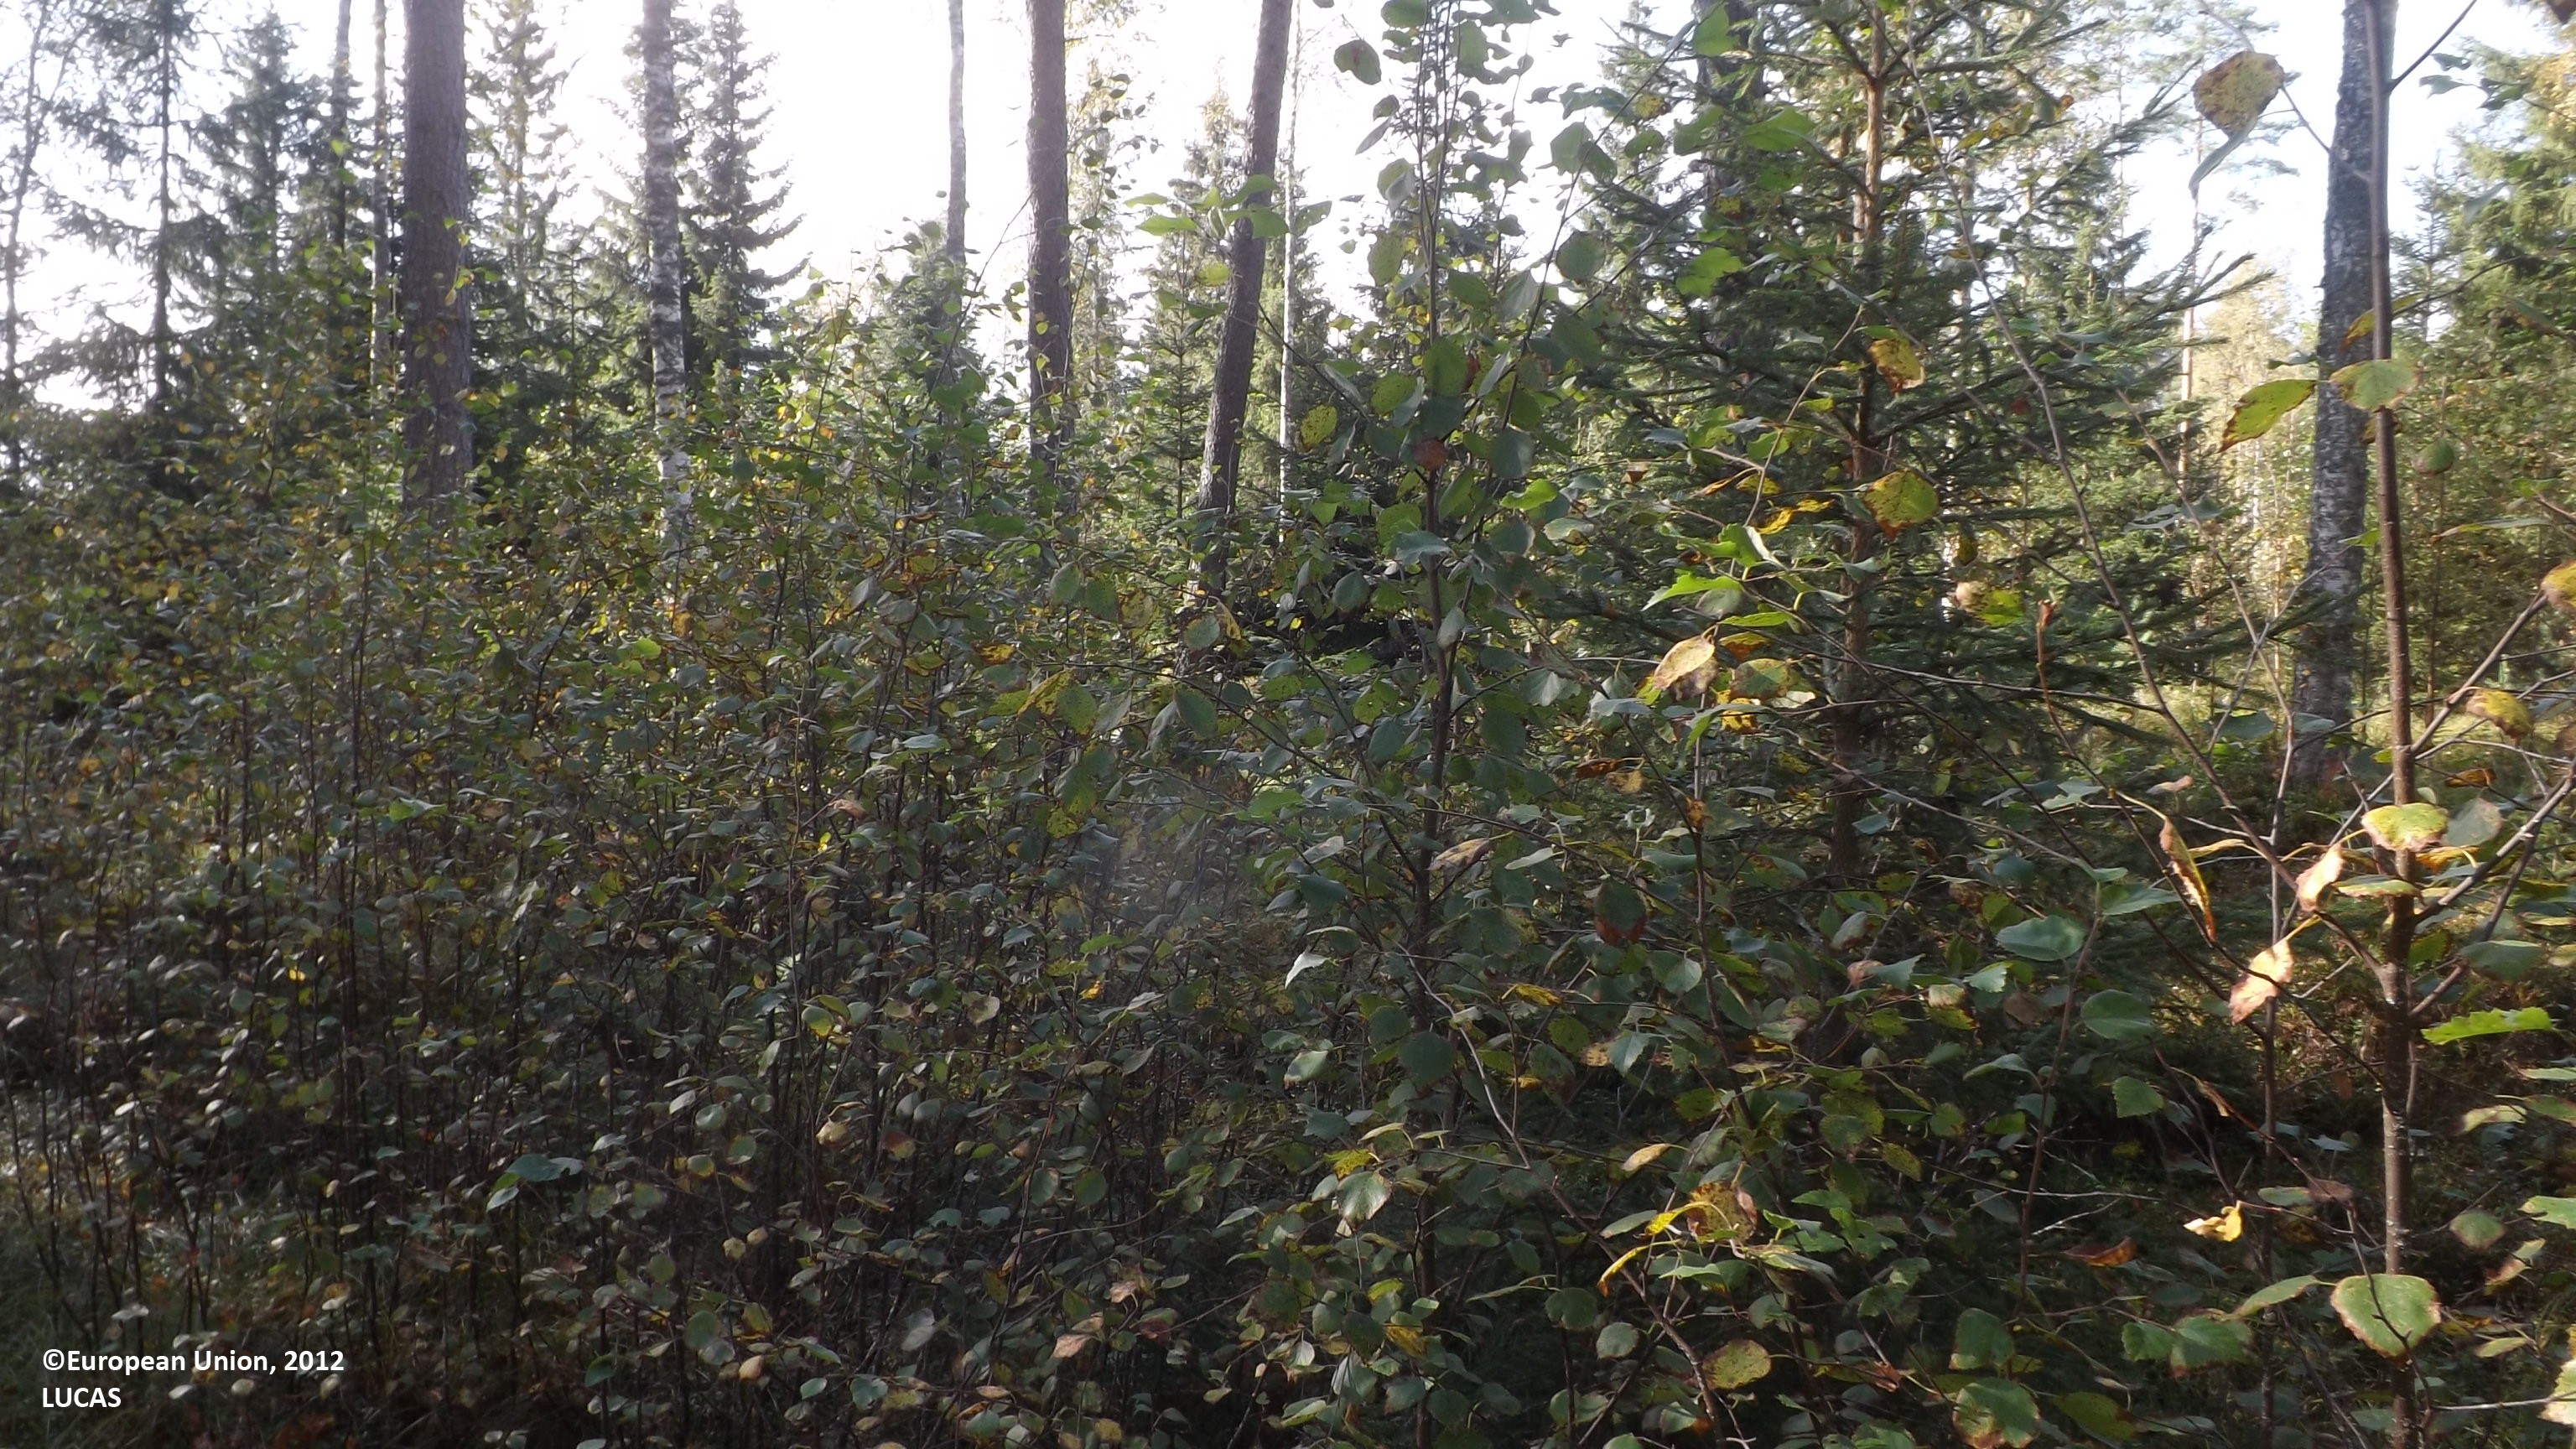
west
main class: Woodland
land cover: Pine dominated mixed woodland
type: boreal forest
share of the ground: 50 - 75 %
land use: Forestry
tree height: > 5 m
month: August
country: FI
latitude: 63.9076
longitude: 23.7358
